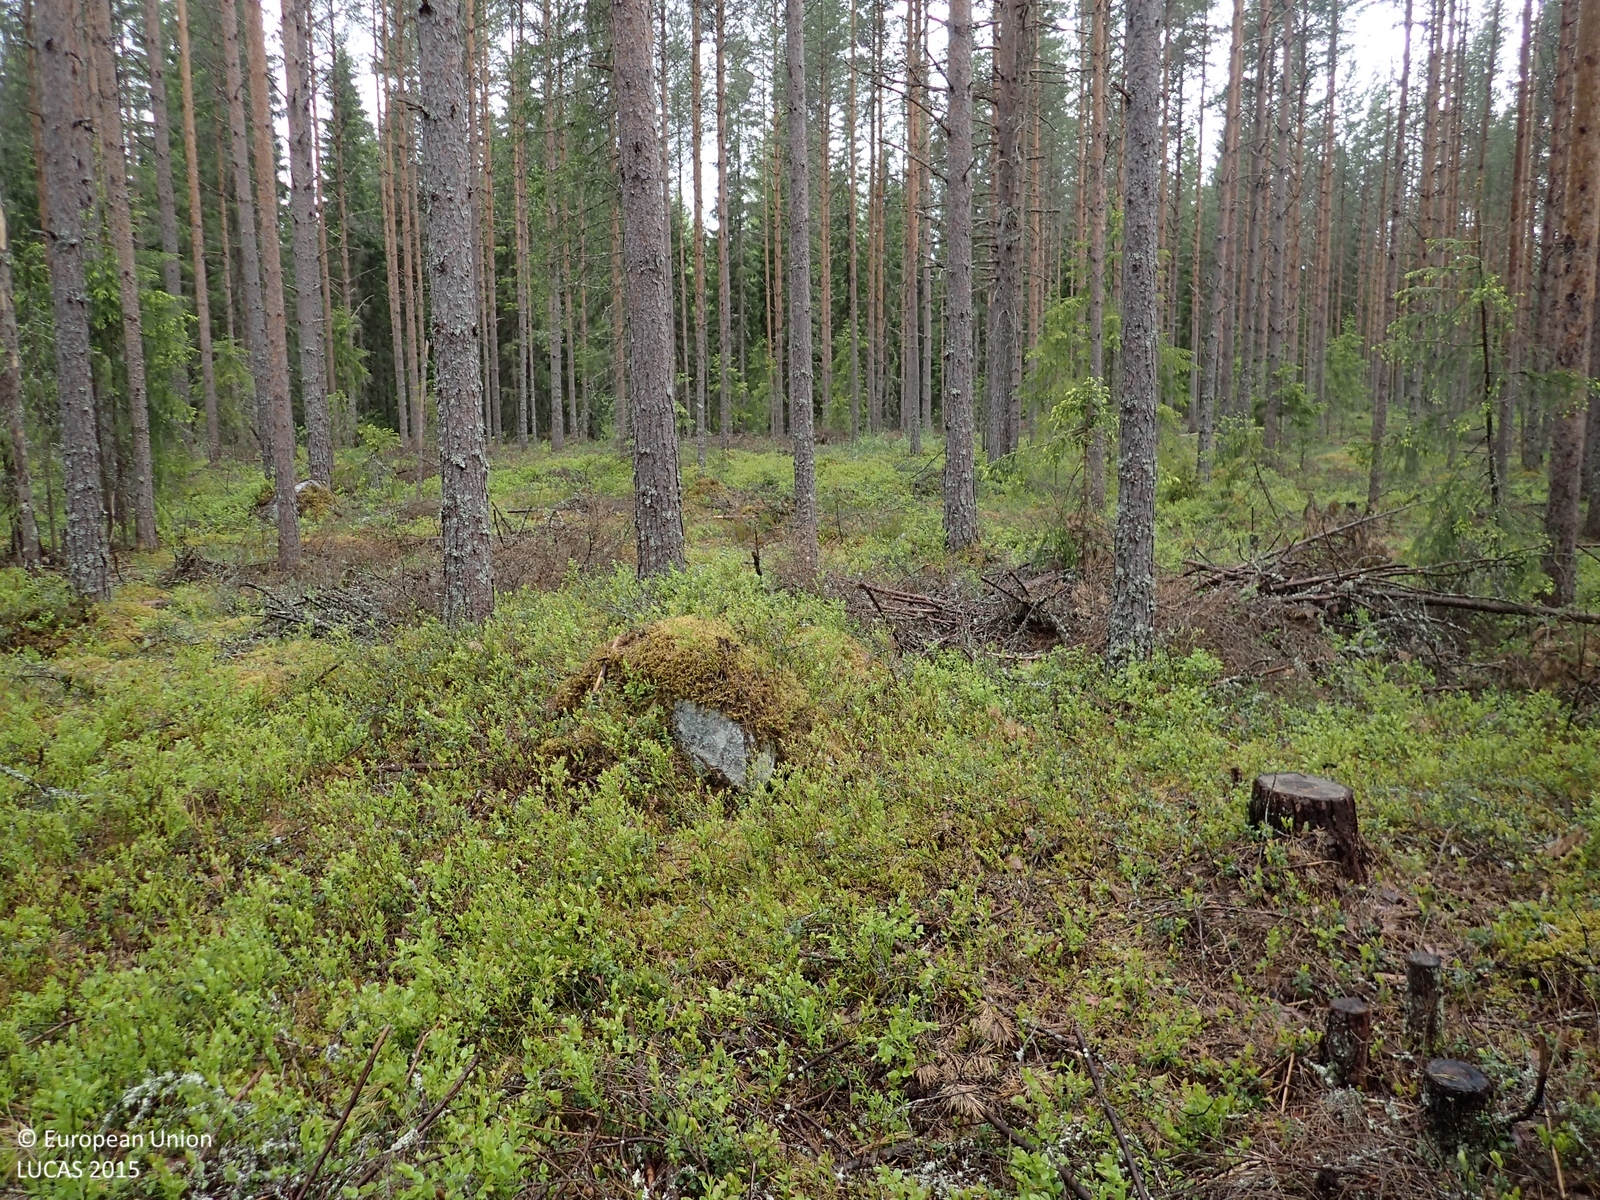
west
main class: Woodland
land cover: Pine dominated coniferous woodland
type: boreal forest
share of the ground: > 75 %
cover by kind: coniferous forest trees 75 %, shrubs 15 %, herbaceous plants 5 %, lichens and mosses 5 %
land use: Forestry
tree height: > 5 m
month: June
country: FI
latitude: 62.2140
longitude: 21.6420
